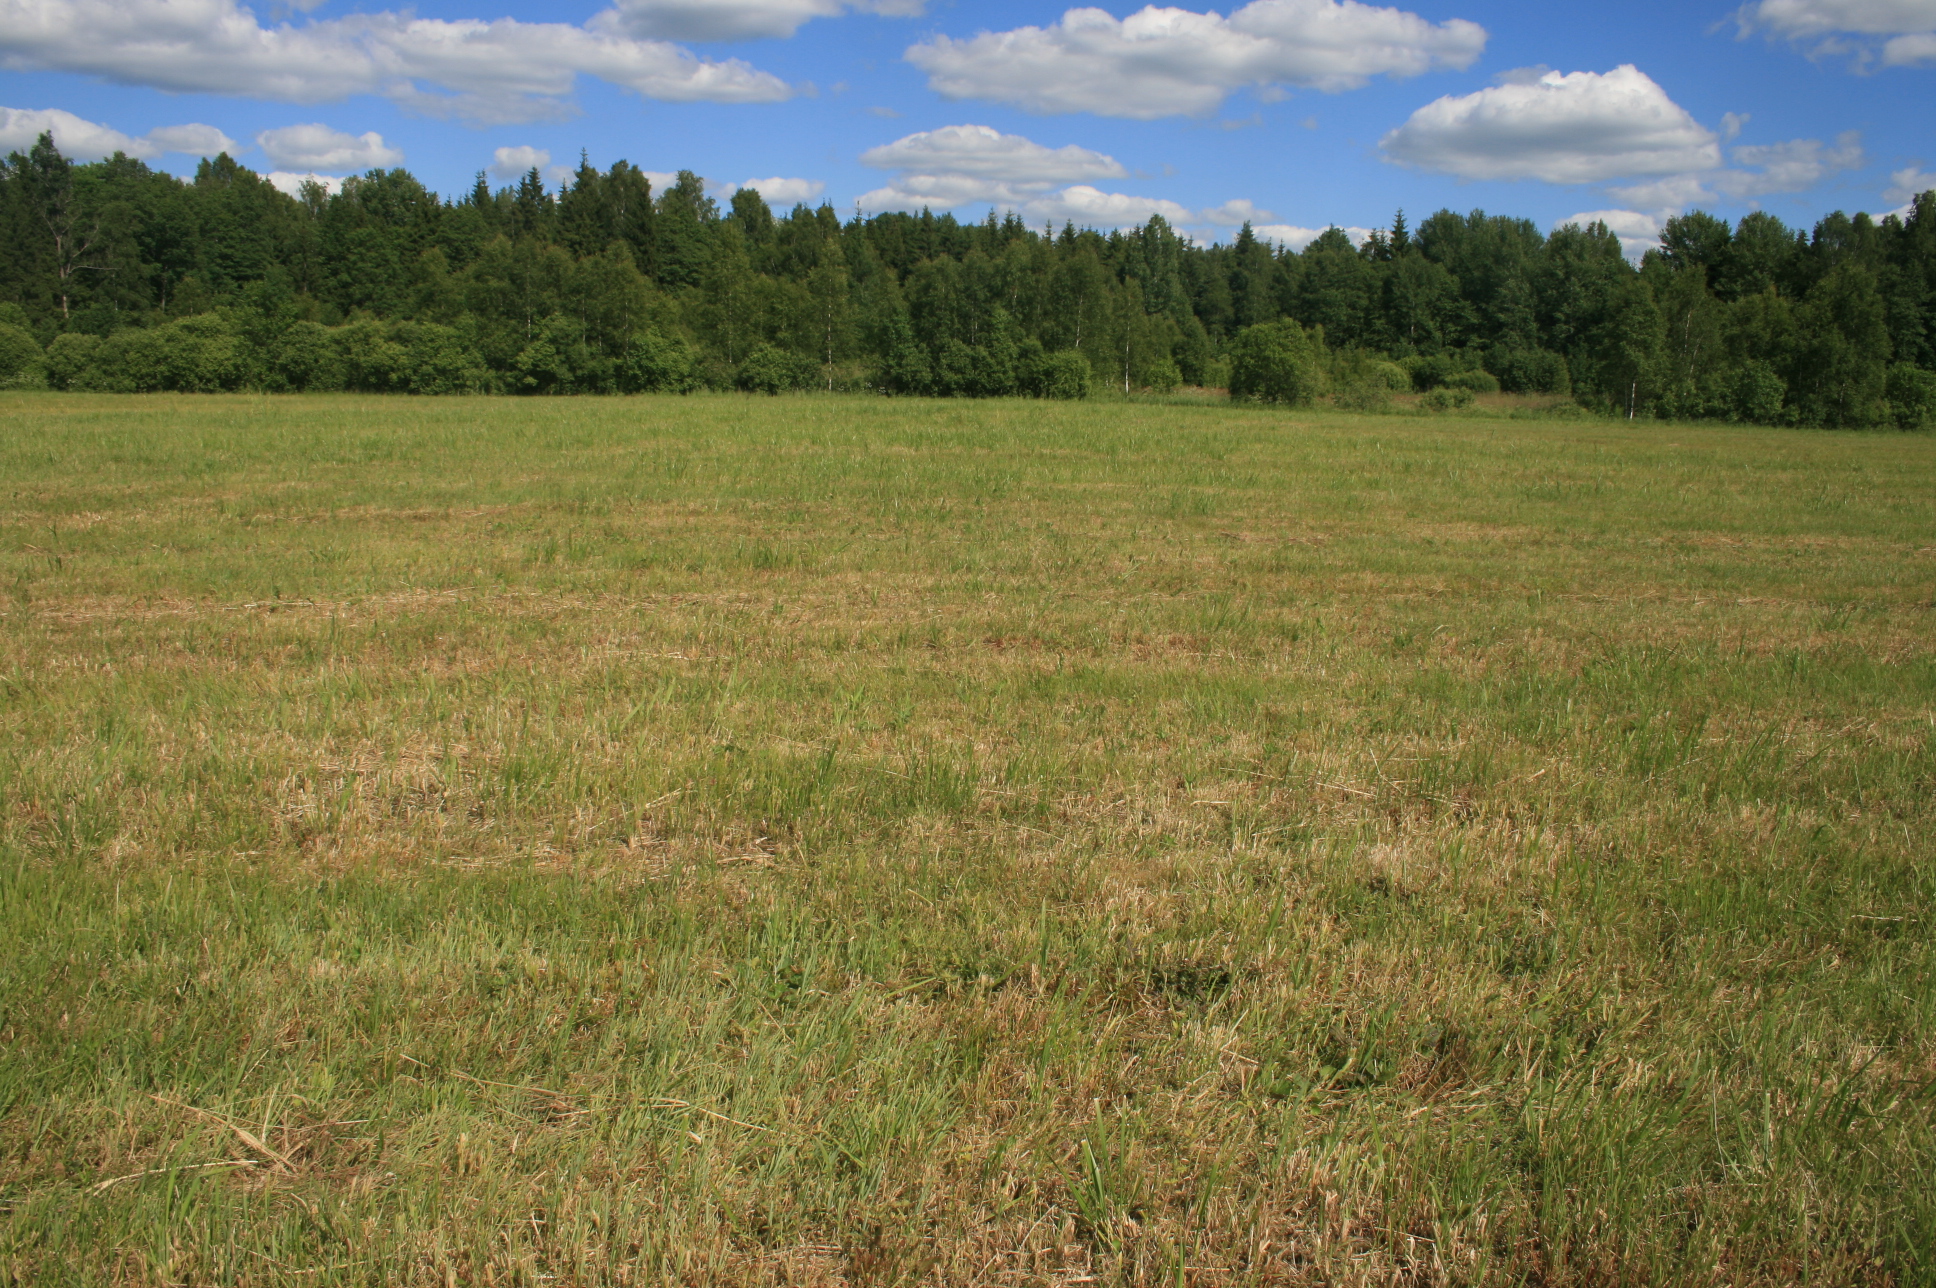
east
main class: Grassland
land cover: Grassland without tree/shrub cover
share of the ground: > 75 %
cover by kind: herbaceous plants 95 %, lichens and mosses 5 %
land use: Agriculture (excluding fallow land and kitchen gardens)
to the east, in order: Grassland without tree/shrub cover; Abandoned hedges; Ditches and canals; Spontaneously vegetated surfaces; Grassland without tree/shrub cover; Abandoned hedges; Spontaneously vegetated surfaces; Broadleaved woodland; Spontaneously vegetated surfaces; Broadleaved woodland; Ditches and canals; Broadleaved woodland; Spruce dominated coniferous woodland
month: June
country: LT
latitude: 55.4087
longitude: 22.1380
